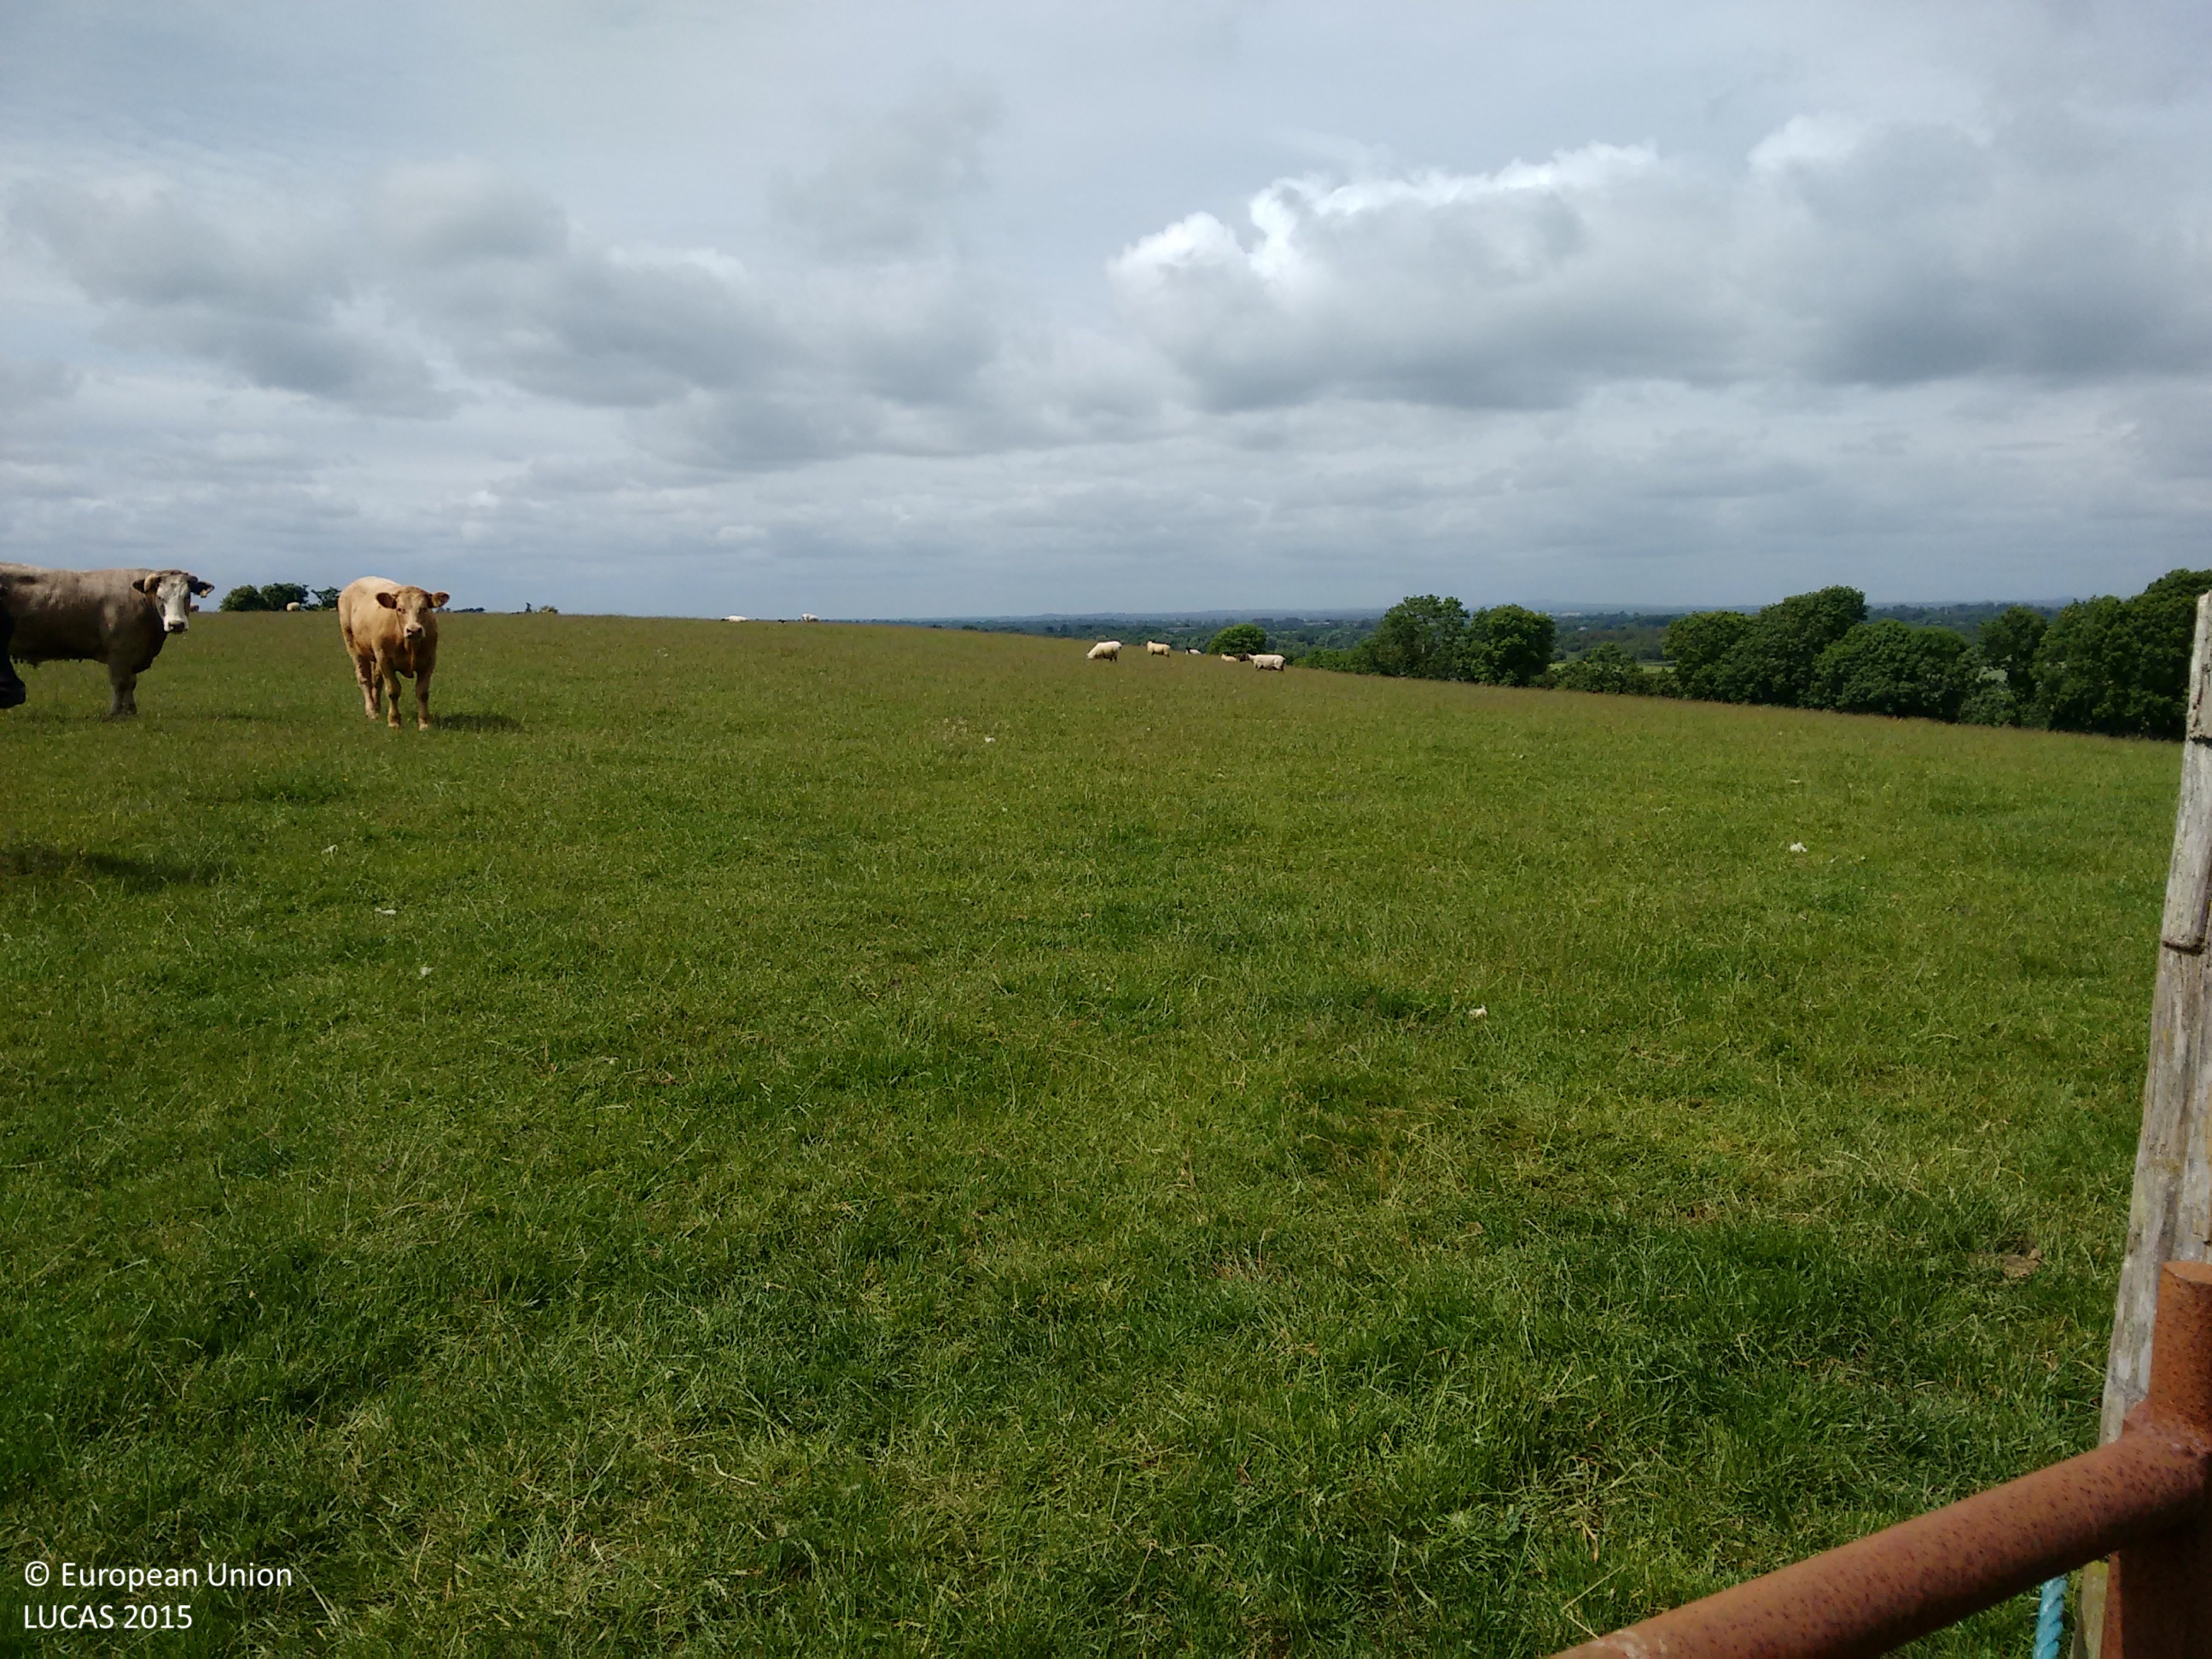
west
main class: Grassland
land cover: Grassland without tree/shrub cover
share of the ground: > 75 %
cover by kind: herbaceous plants 100 %
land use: Agriculture (excluding fallow land and kitchen gardens)
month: June
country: IE
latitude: 53.7418
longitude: -6.6730
